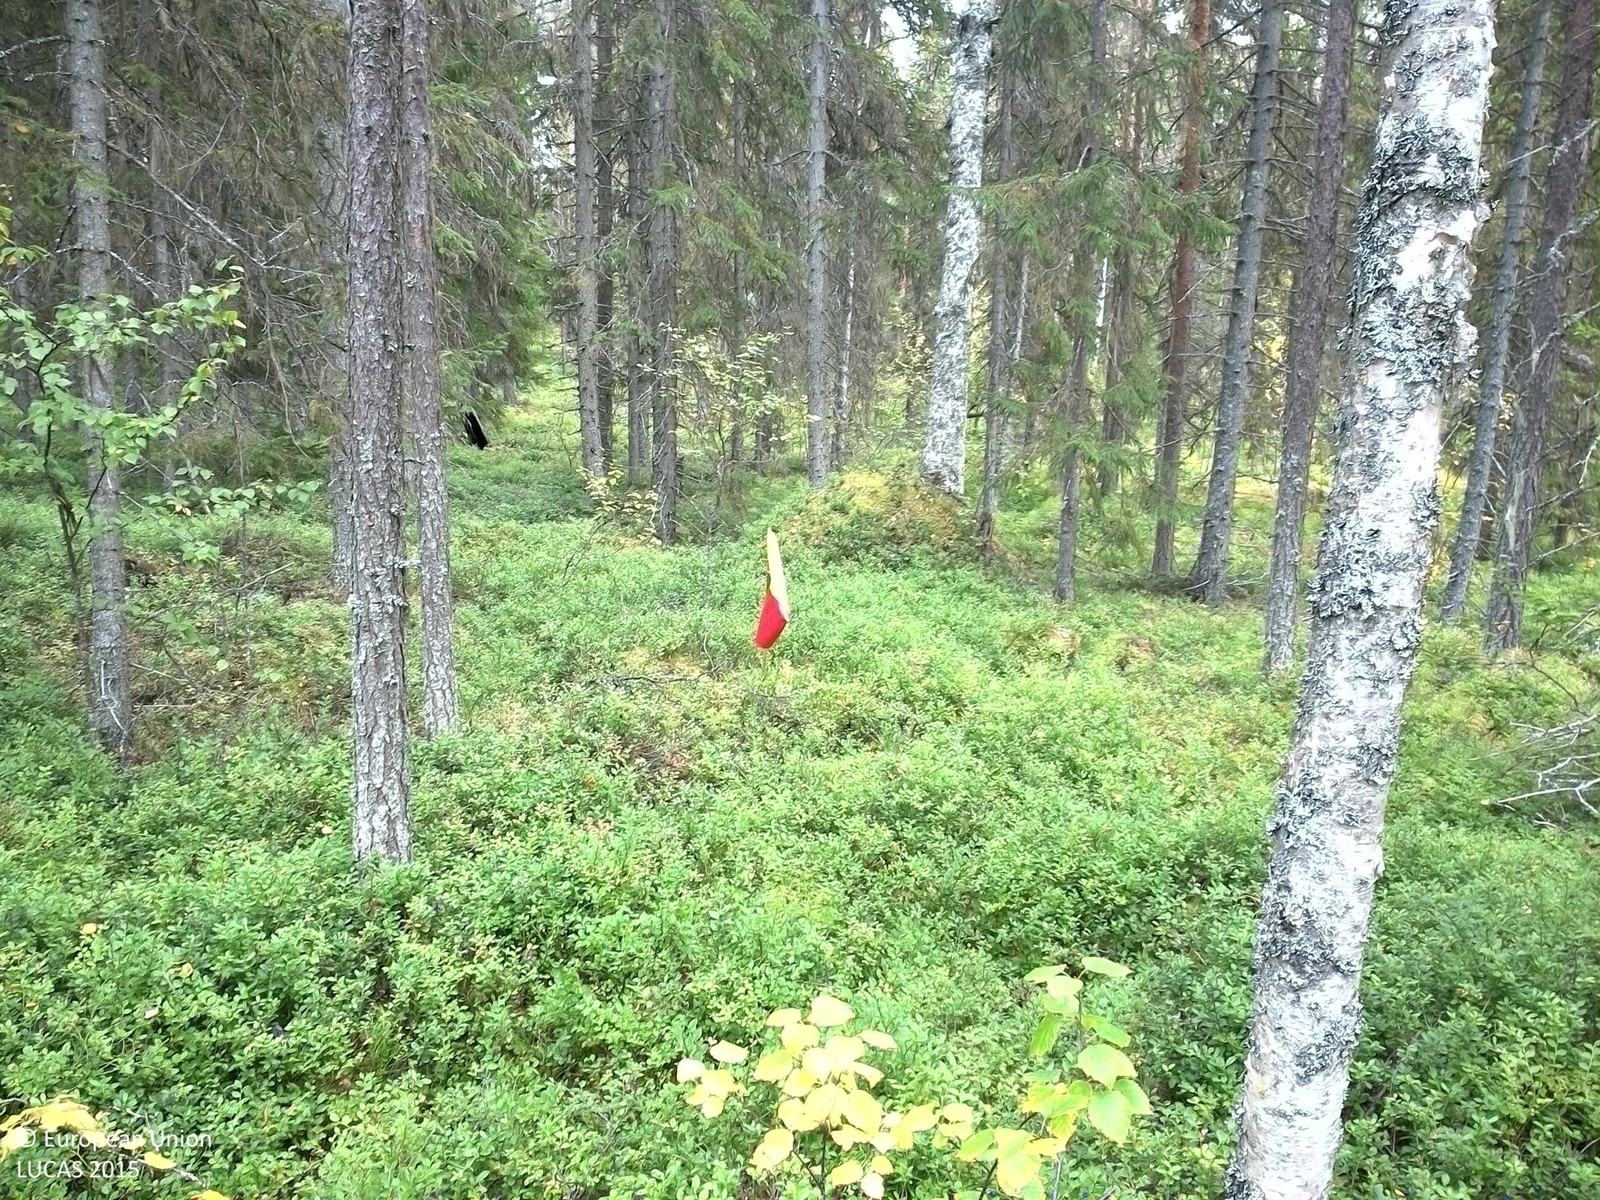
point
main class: Woodland
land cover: Spruce dominated mixed woodland
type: boreal forest
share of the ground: 50 - 75 %
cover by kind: coniferous forest trees 40 %, shrubs 35 %, broadleaved forest trees 15 %, lichens and mosses 10 %
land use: Forestry
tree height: > 5 m
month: September
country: SE
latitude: 63.8662
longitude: 16.5036
